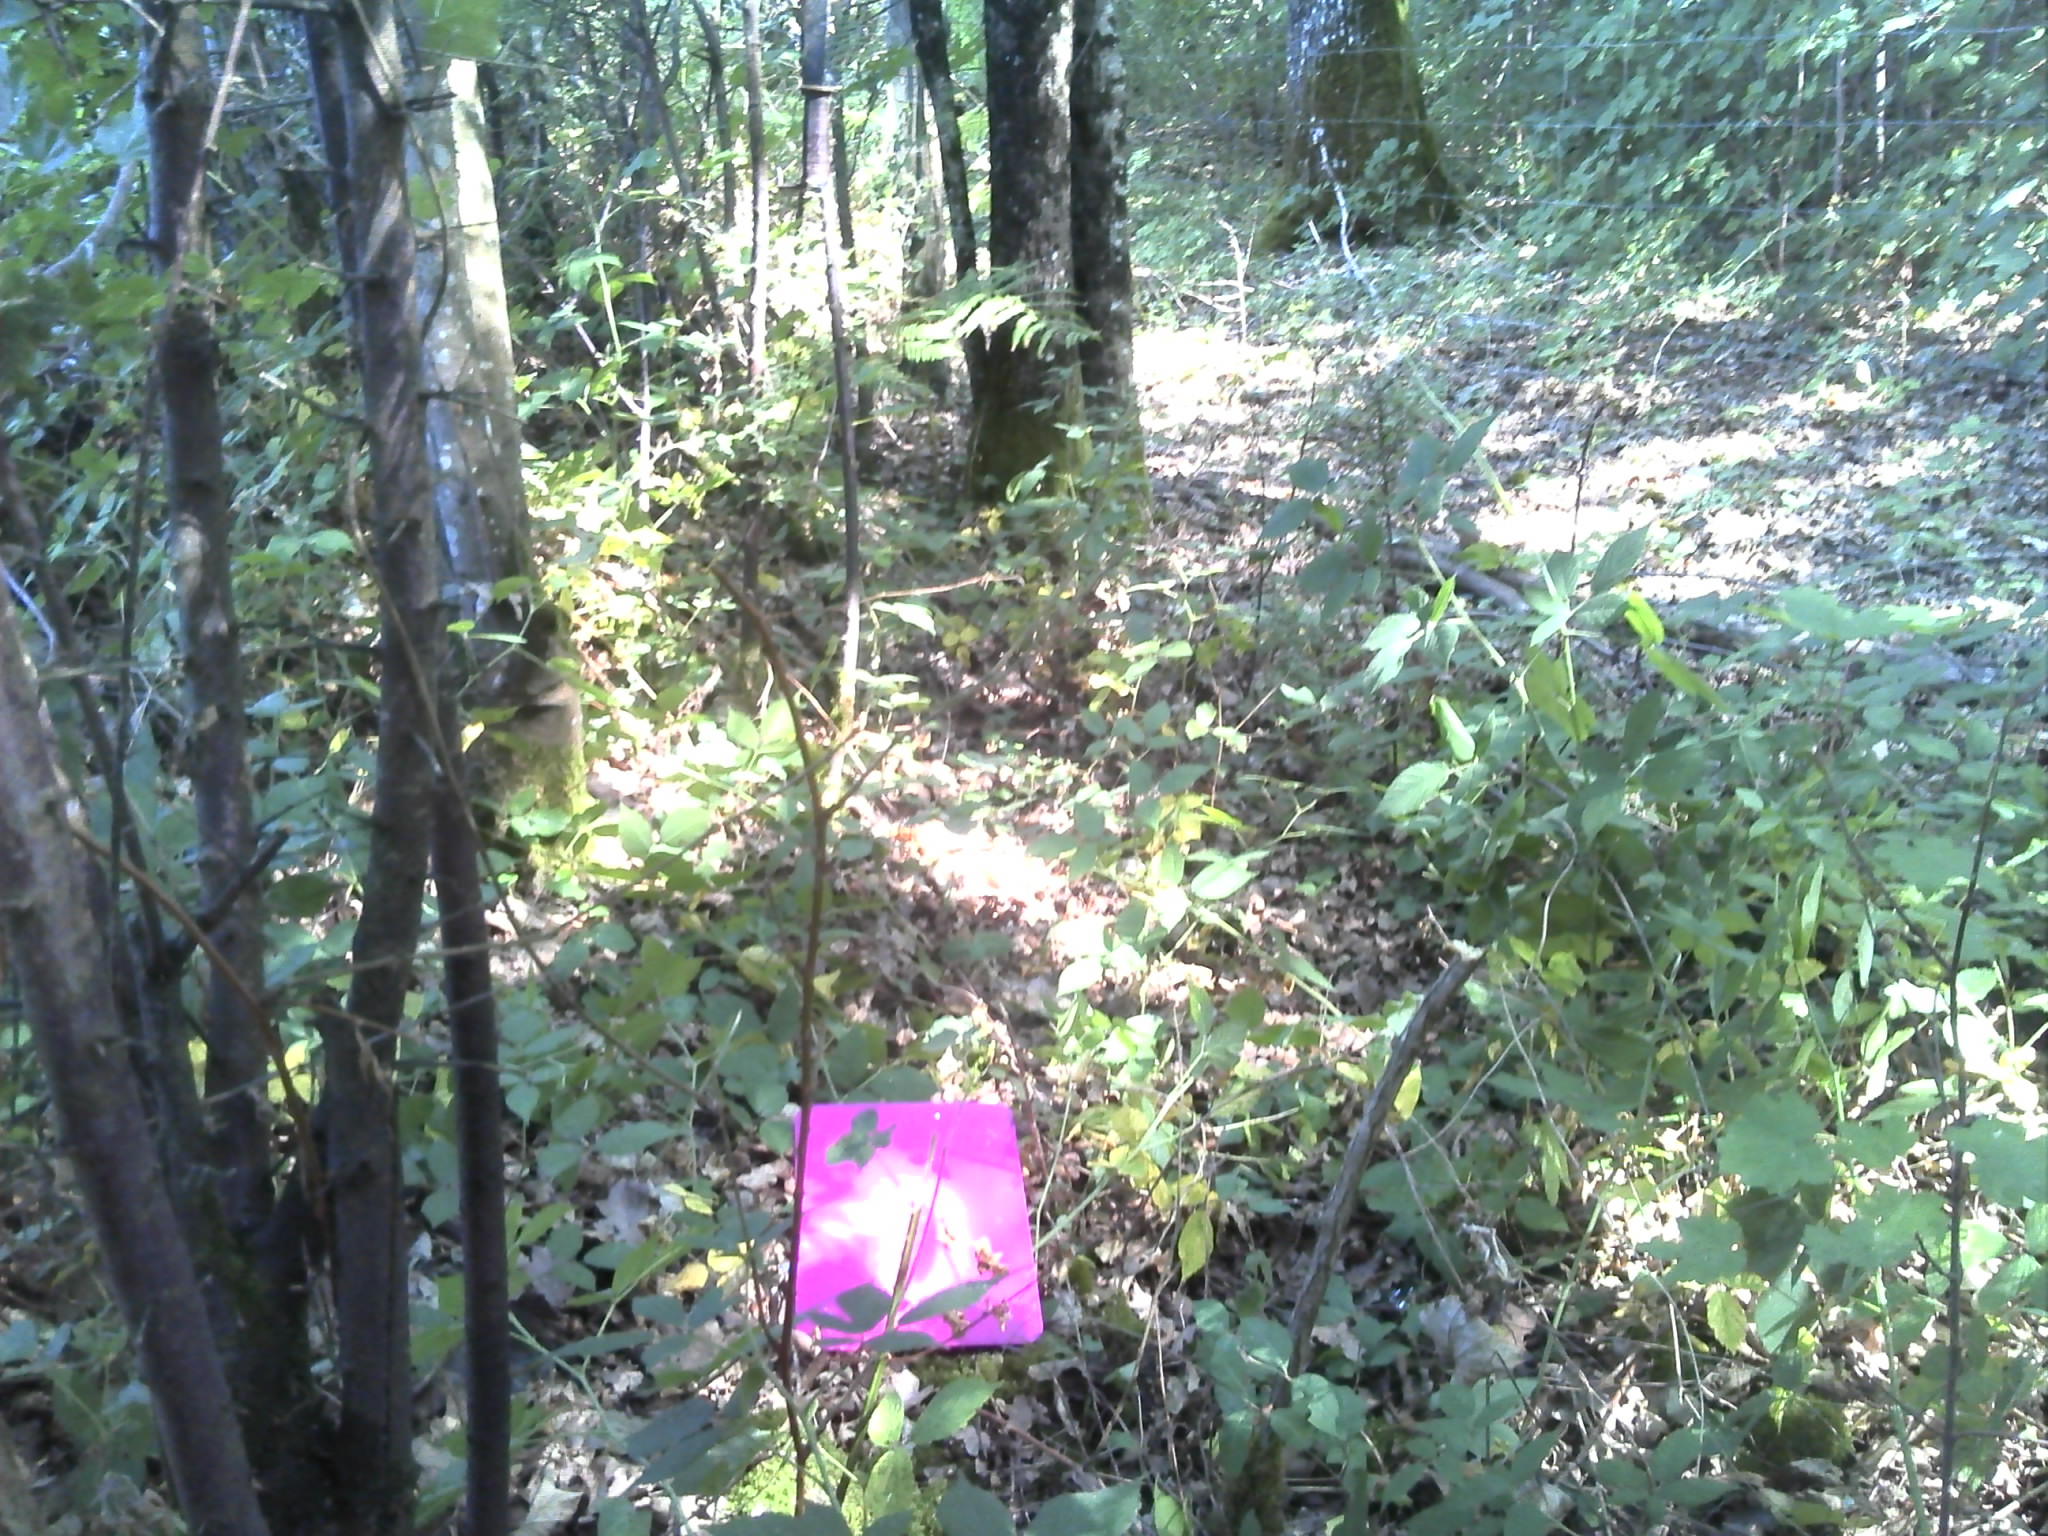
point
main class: Woodland
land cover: Broadleaved woodland
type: mesophytic deciduous forest
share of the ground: > 75 %
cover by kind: broadleaved forest trees 90 %, shrubs 5 %, herbaceous plants 5 %
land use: Forestry
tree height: > 5 m
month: July
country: FR
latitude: 47.0166
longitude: 1.6086
